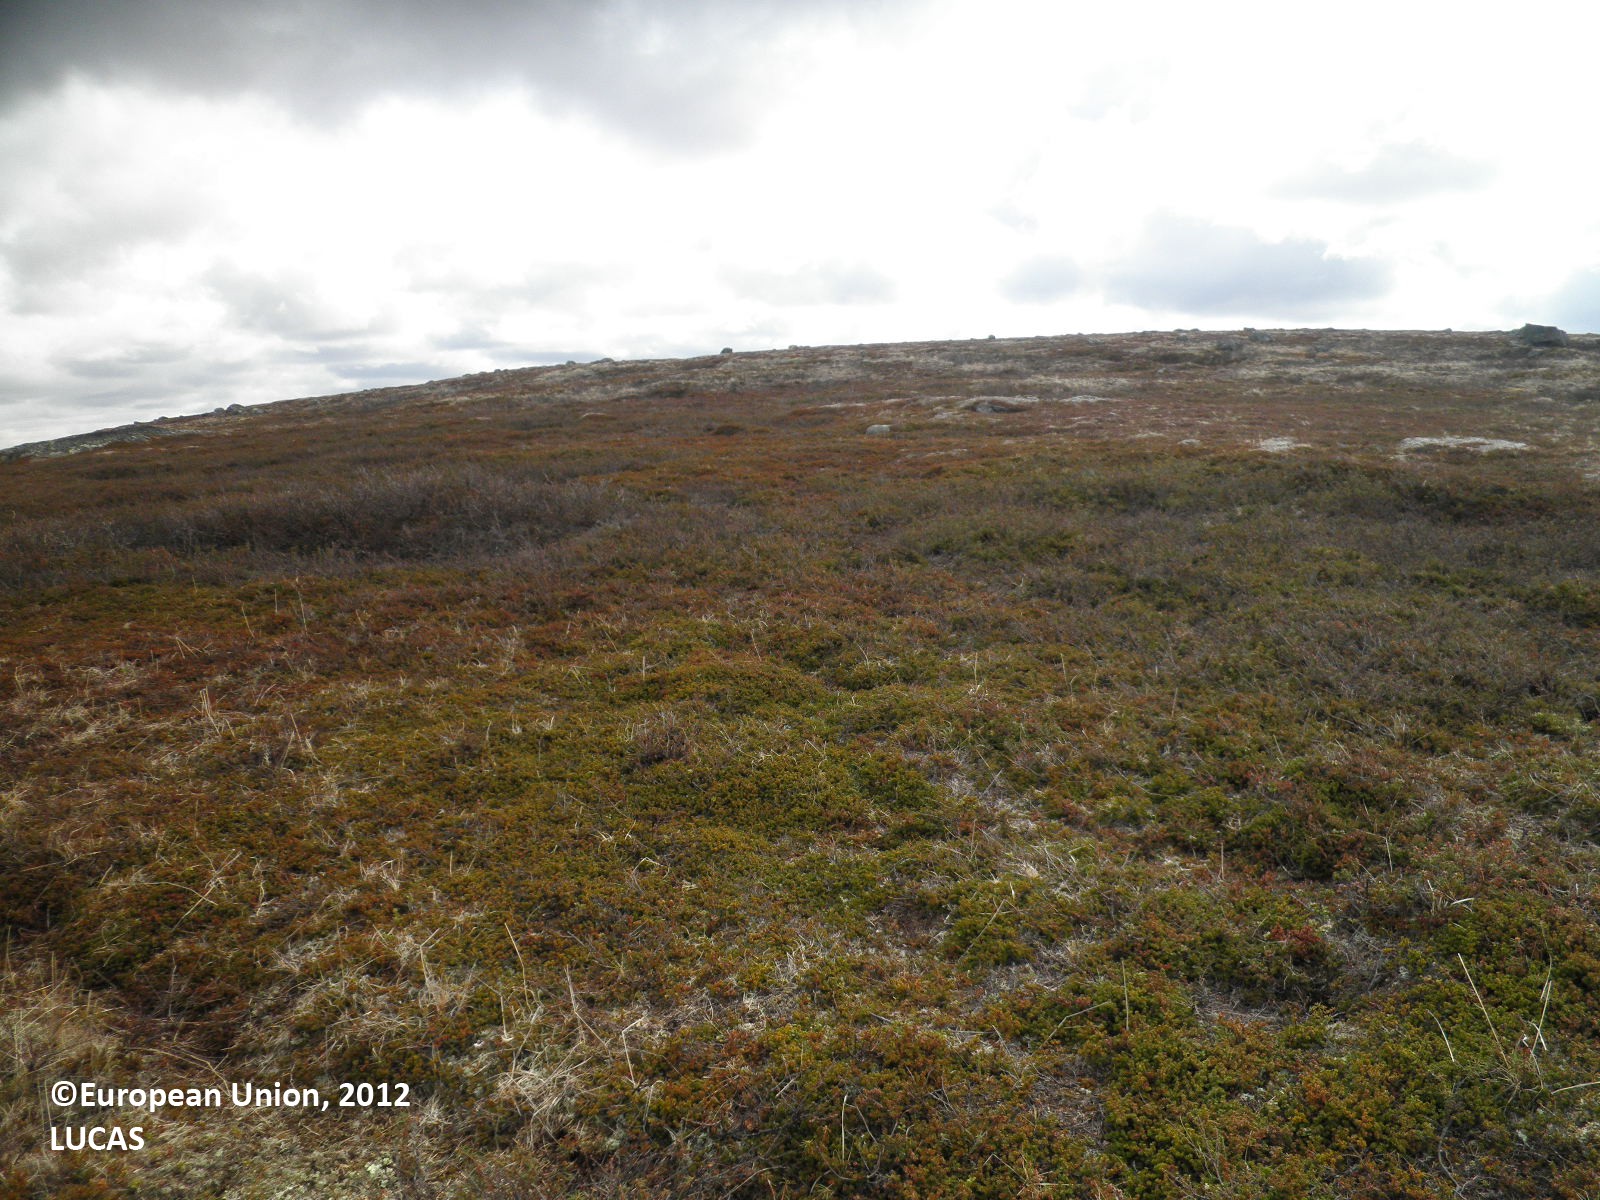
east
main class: Shrubland
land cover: Shrubland without tree cover
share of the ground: > 75 %
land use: Semi-natural and natural areas not in use
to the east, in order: Shrubland without tree cover
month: May
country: FI
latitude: 70.0667
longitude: 27.9062
